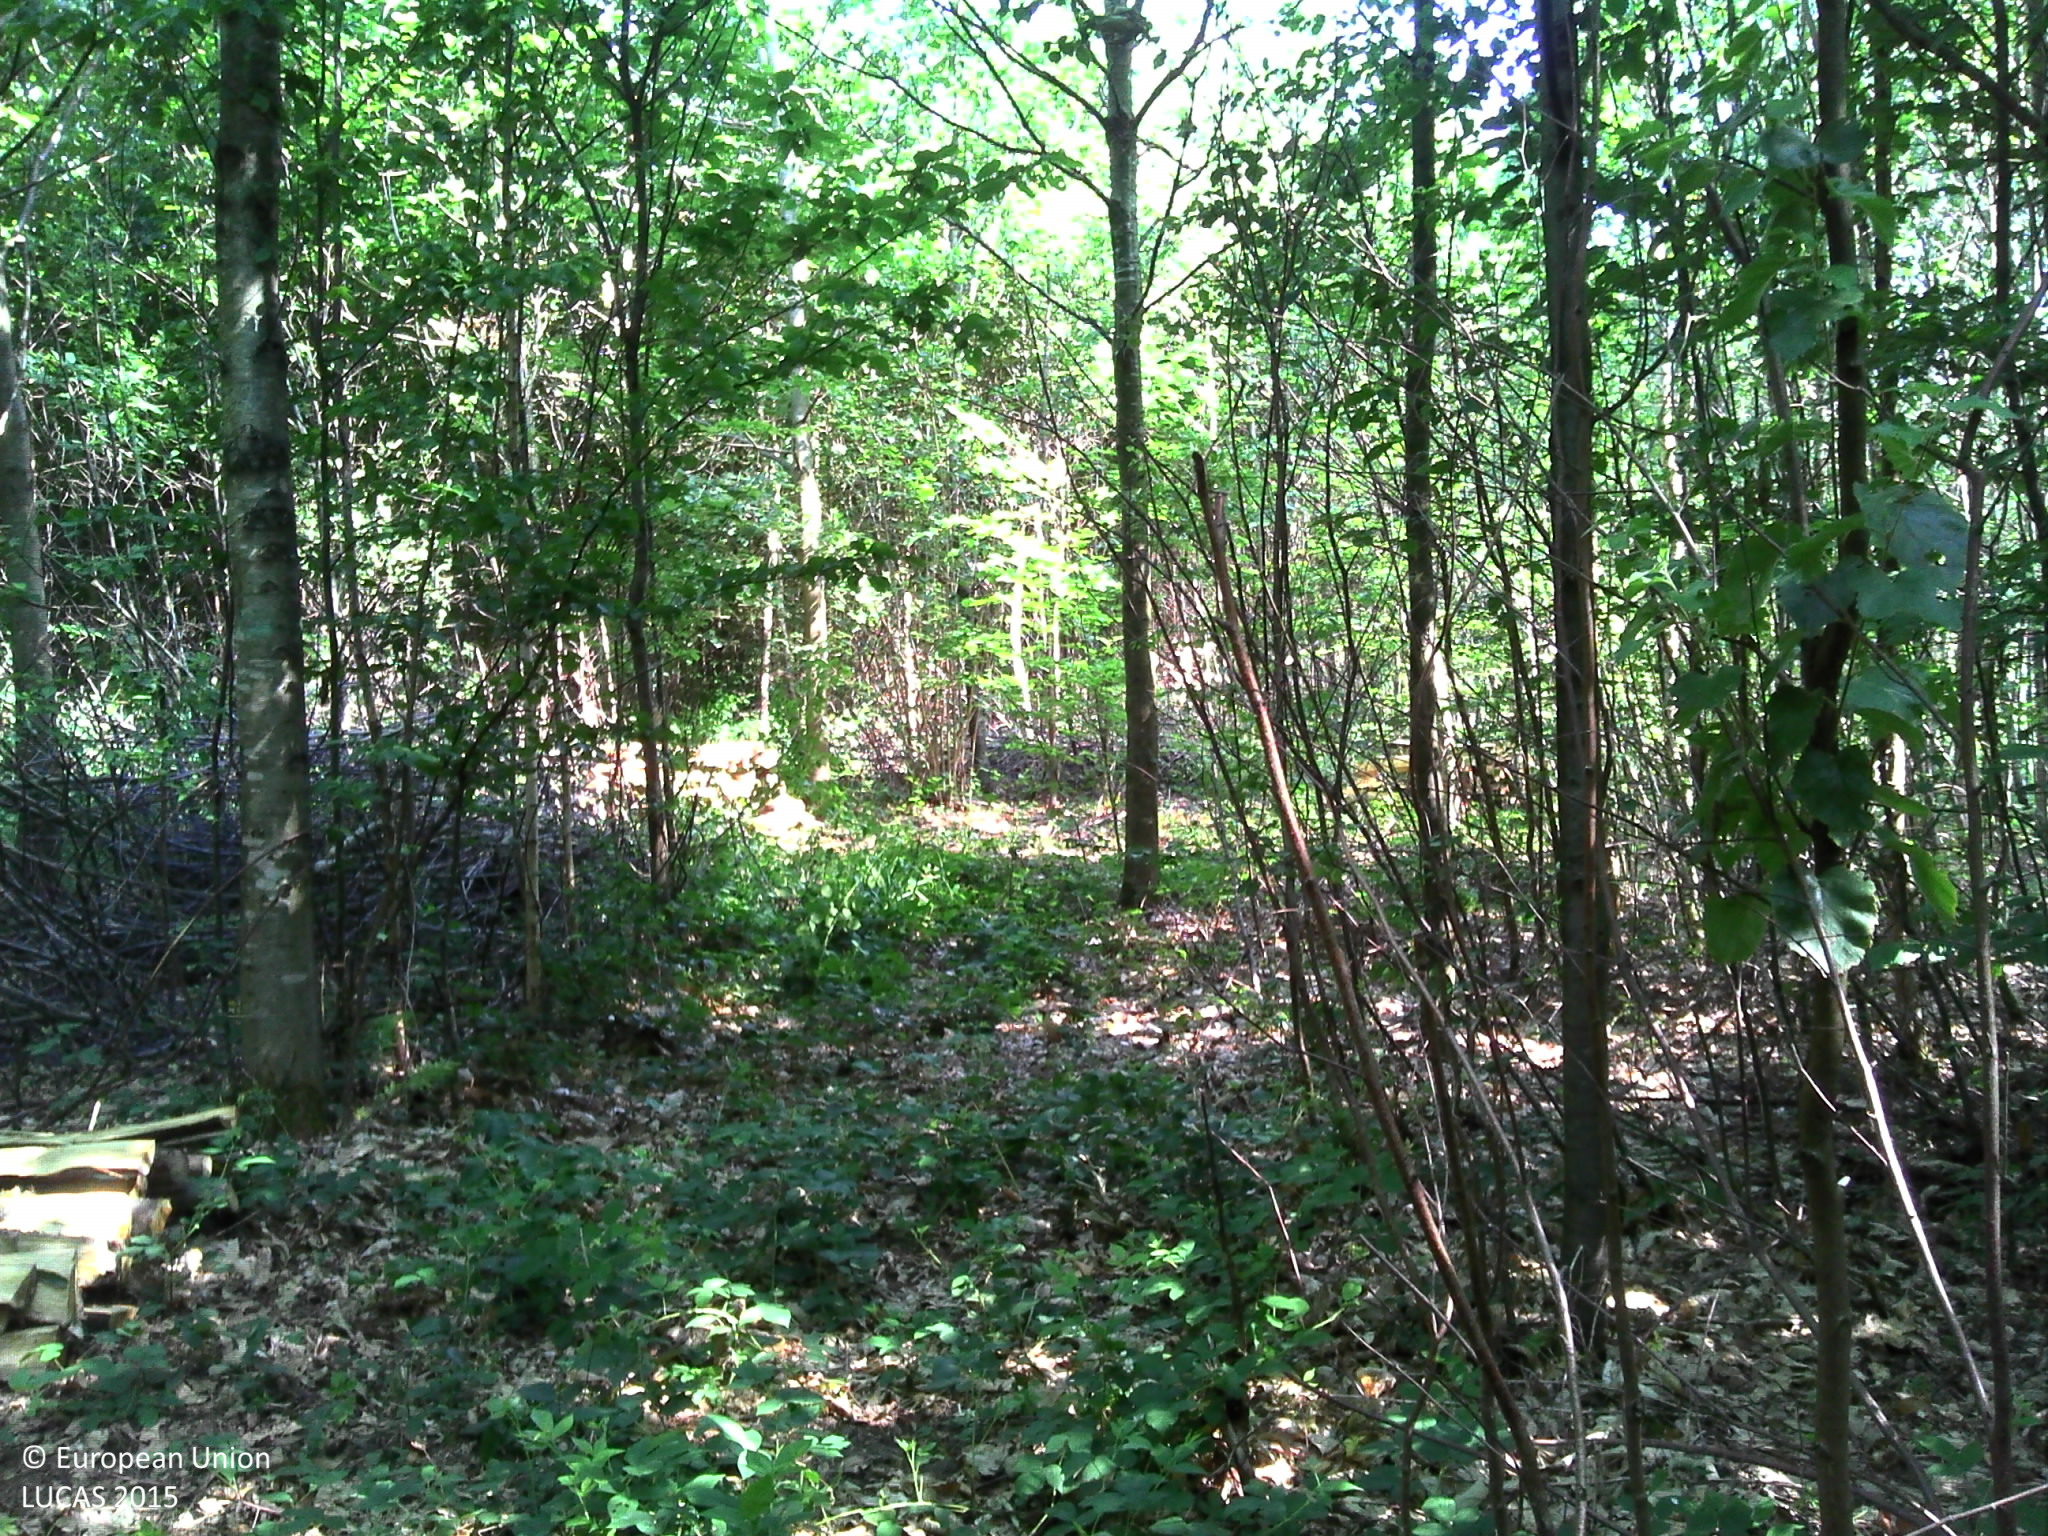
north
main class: Woodland
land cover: Broadleaved woodland
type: exotic forest
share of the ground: > 75 %
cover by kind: broadleaved forest trees 85 %, herbaceous plants 10 %, unconsolidated bare surface 5 %
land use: Forestry
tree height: > 5 m
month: July
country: BE
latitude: 50.2876
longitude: 4.5363
